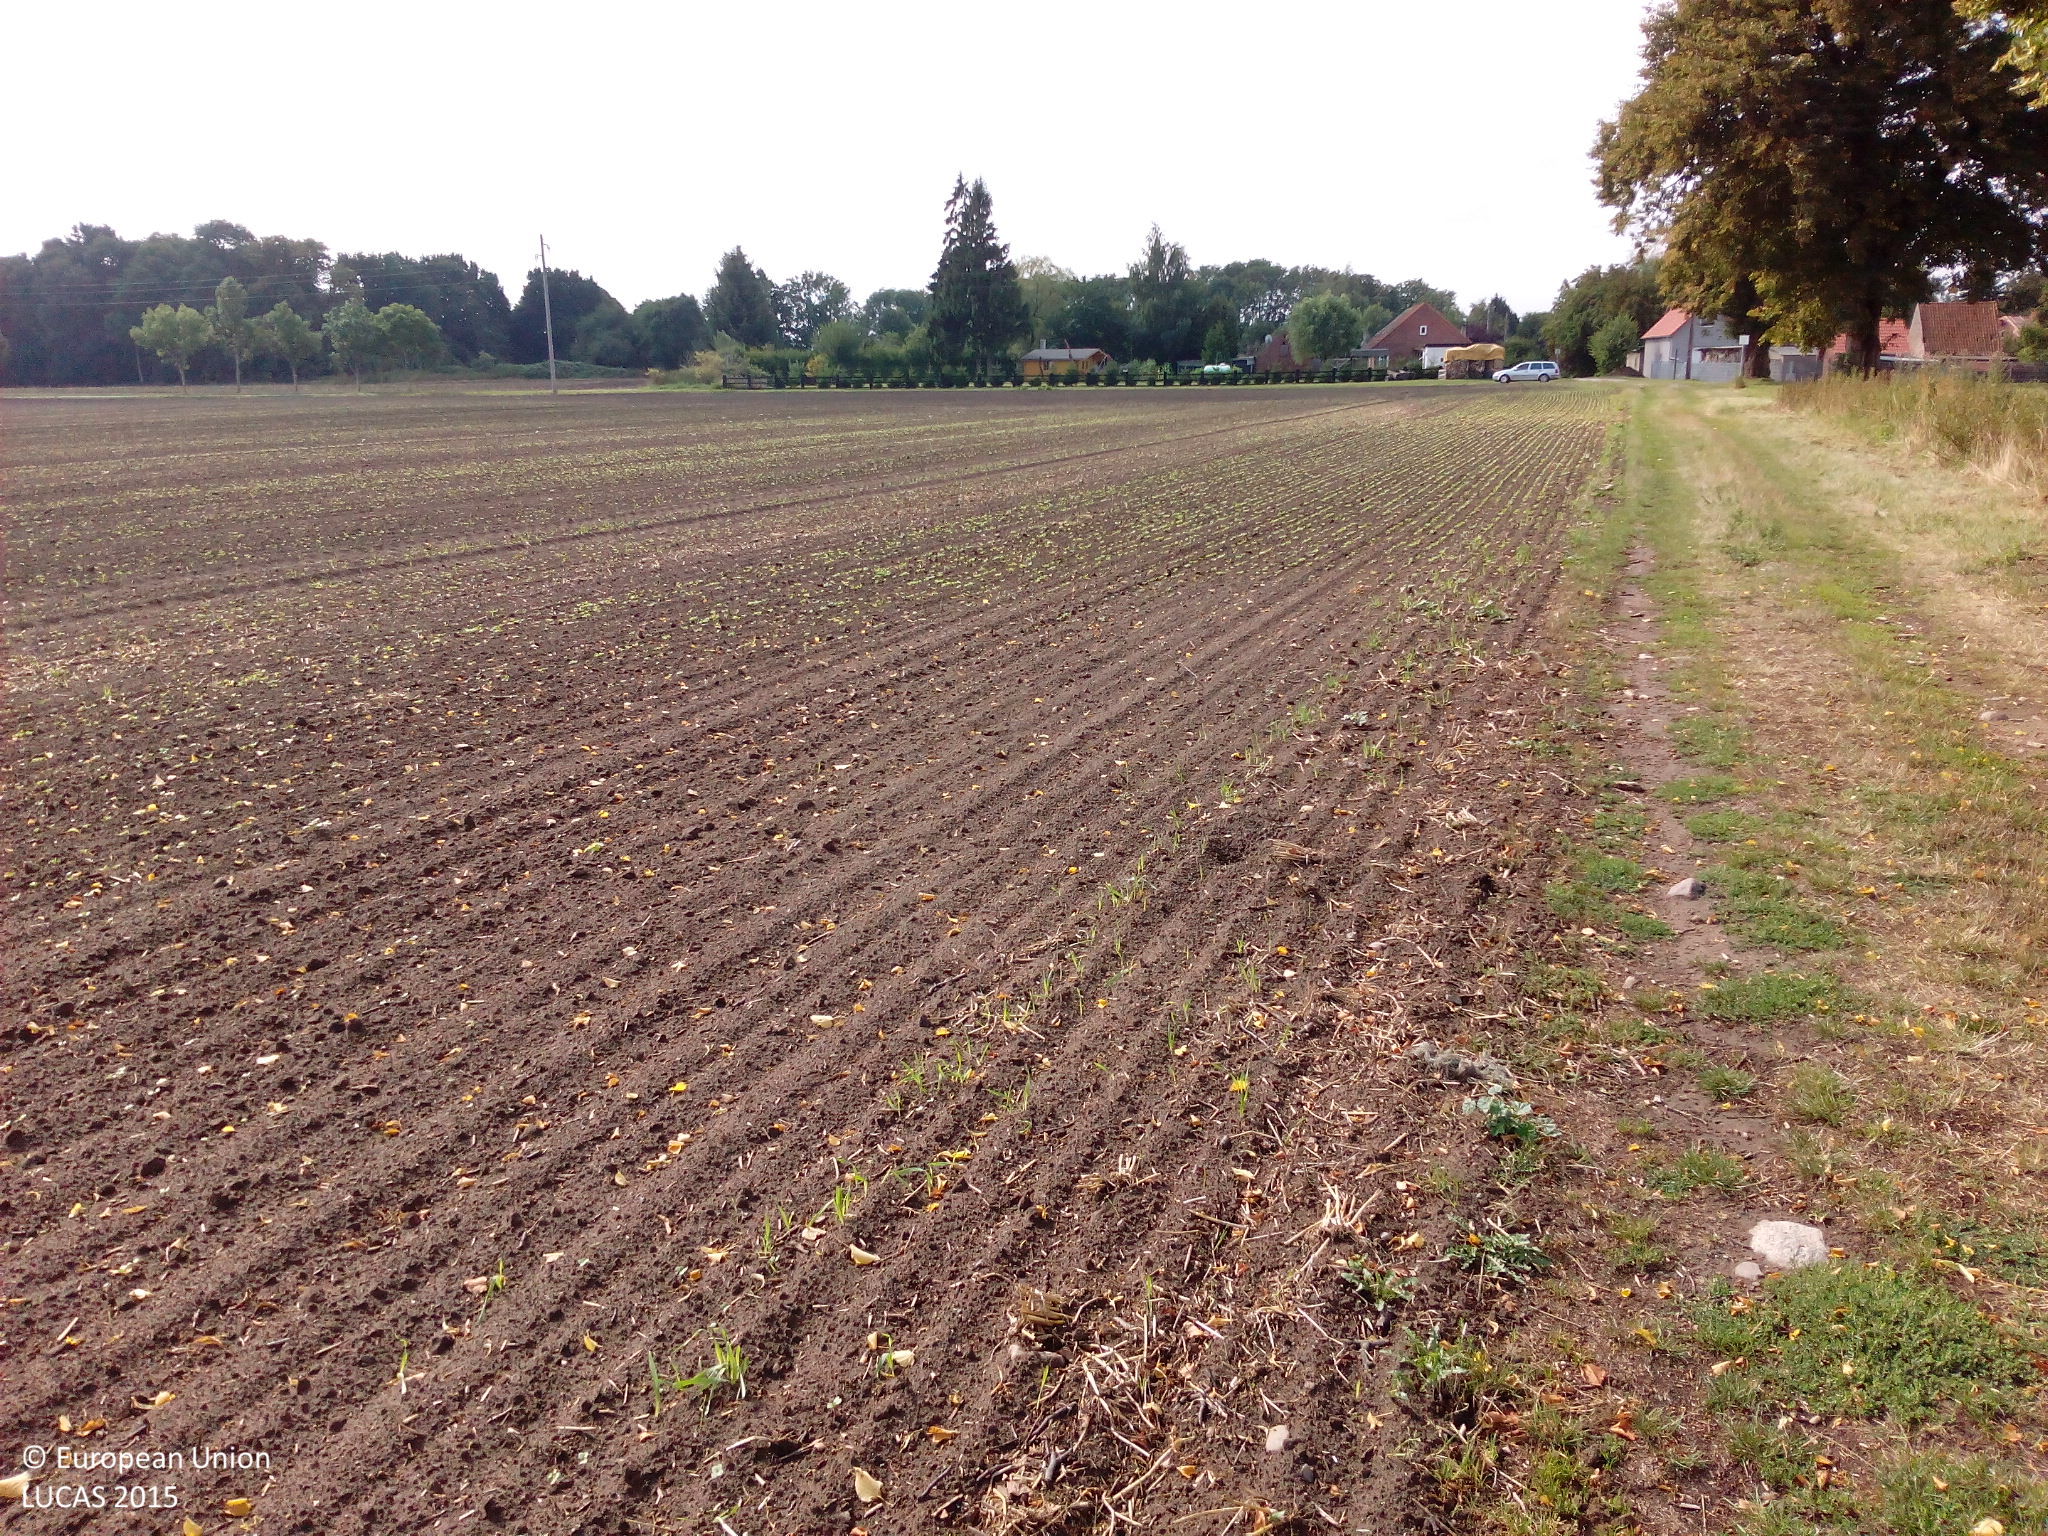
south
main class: Cropland
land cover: Rape and turnip rape
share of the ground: < 10 %
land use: Agriculture (excluding fallow land and kitchen gardens)
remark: Tilled/Sowed
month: August
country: DE
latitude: 54.0192
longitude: 12.7006
